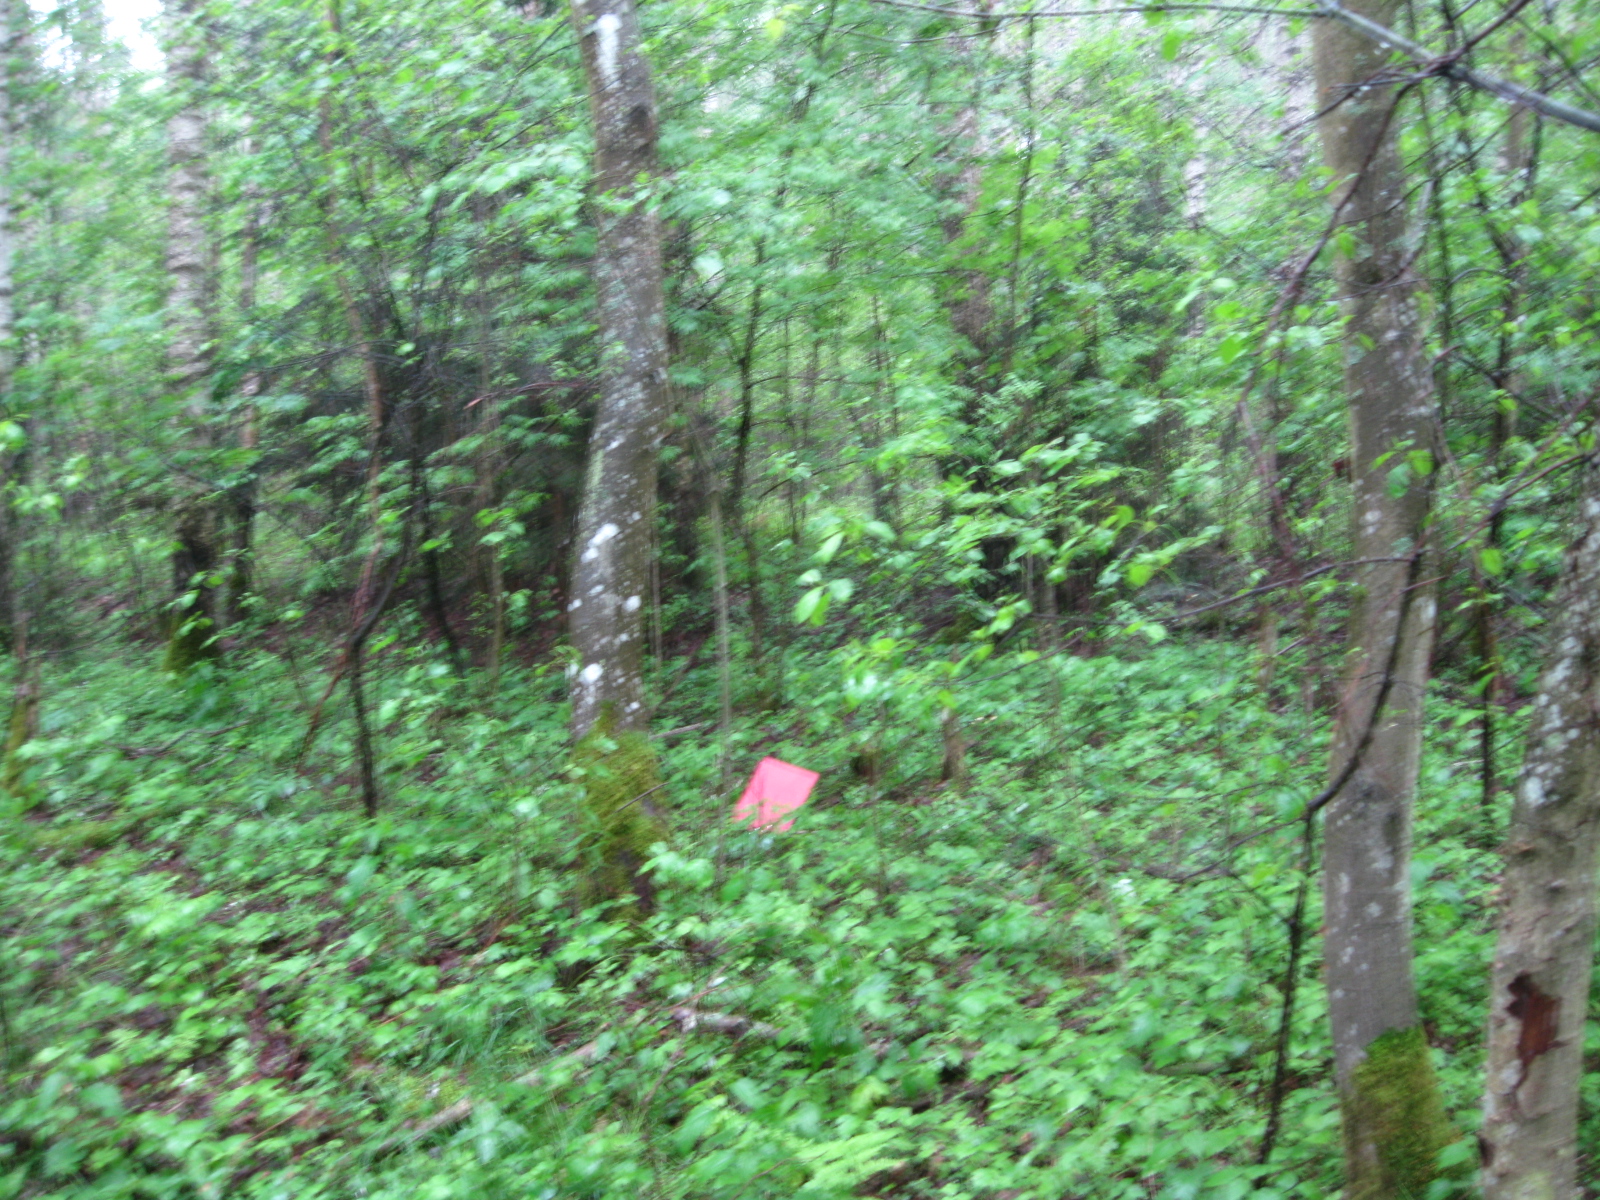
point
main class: Woodland
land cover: Broadleaved woodland
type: non-riverine alder, birch or aspen forest
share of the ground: > 75 %
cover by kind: broadleaved forest trees 80 %, coniferous forest trees 10 %, shrubs 5 %, herbaceous plants 5 %
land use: Forestry
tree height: > 5 m
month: May
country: LT
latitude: 55.8850
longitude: 24.3724
